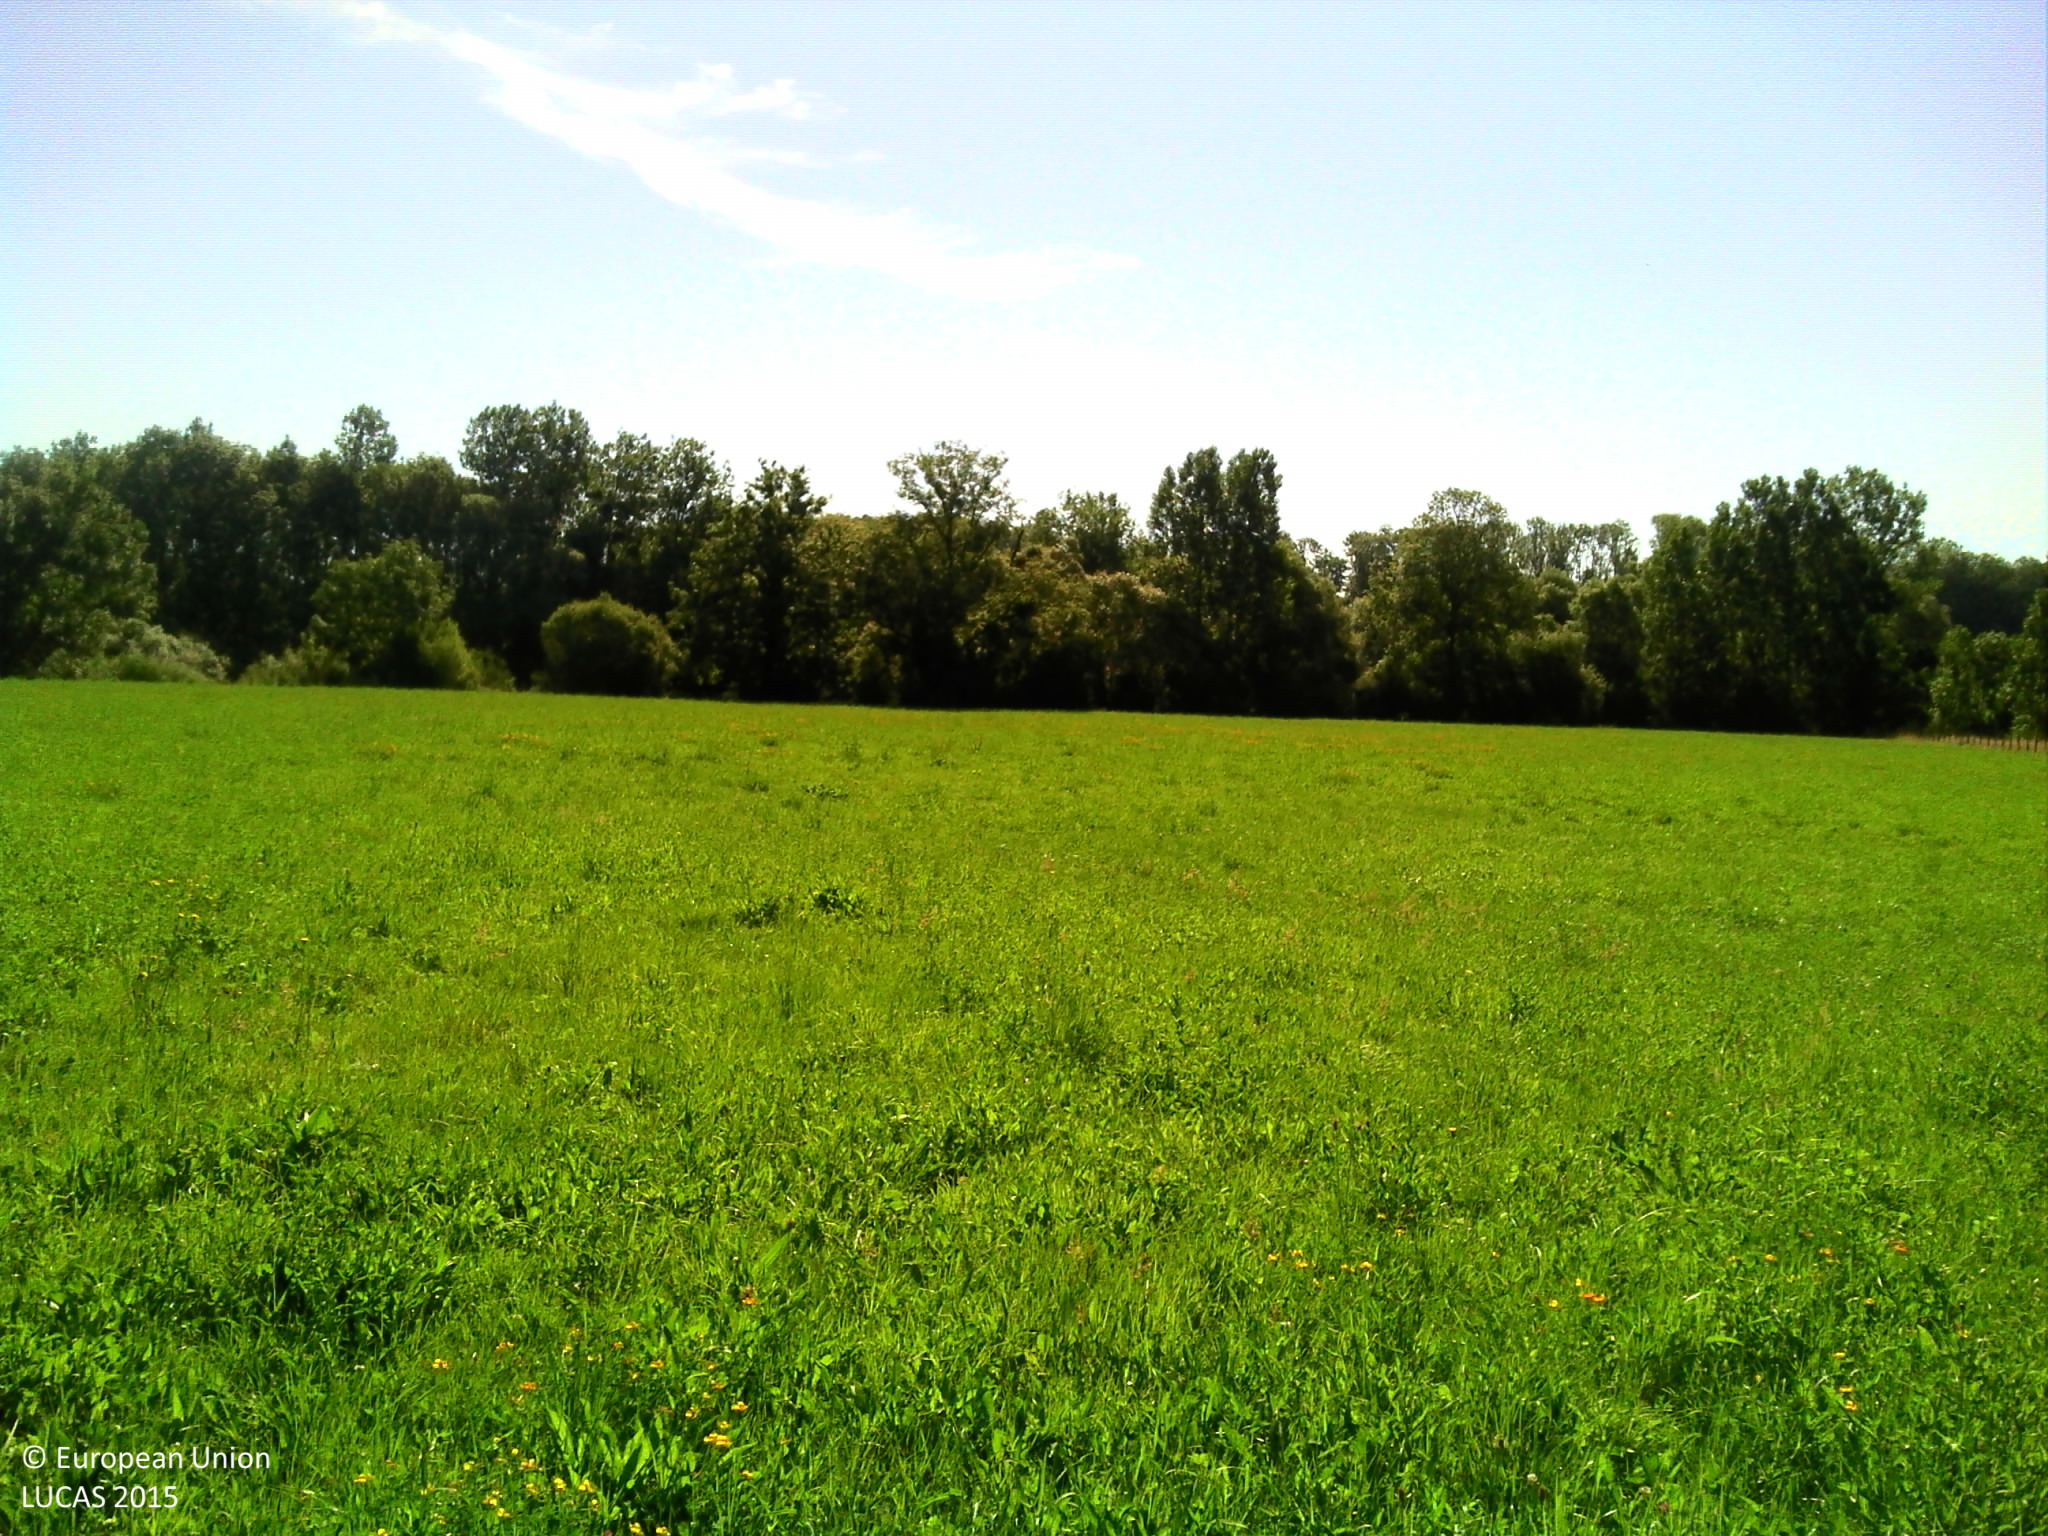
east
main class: Grassland
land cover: Grassland without tree/shrub cover
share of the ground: > 75 %
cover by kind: herbaceous plants 100 %
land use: Agriculture (excluding fallow land and kitchen gardens)
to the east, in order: Grassland without tree/shrub cover; Broadleaved woodland; Inland fresh running water; Broadleaved woodland; Grassland without tree/shrub cover; Maize
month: June
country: FR
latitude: 47.4193
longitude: 6.1974
